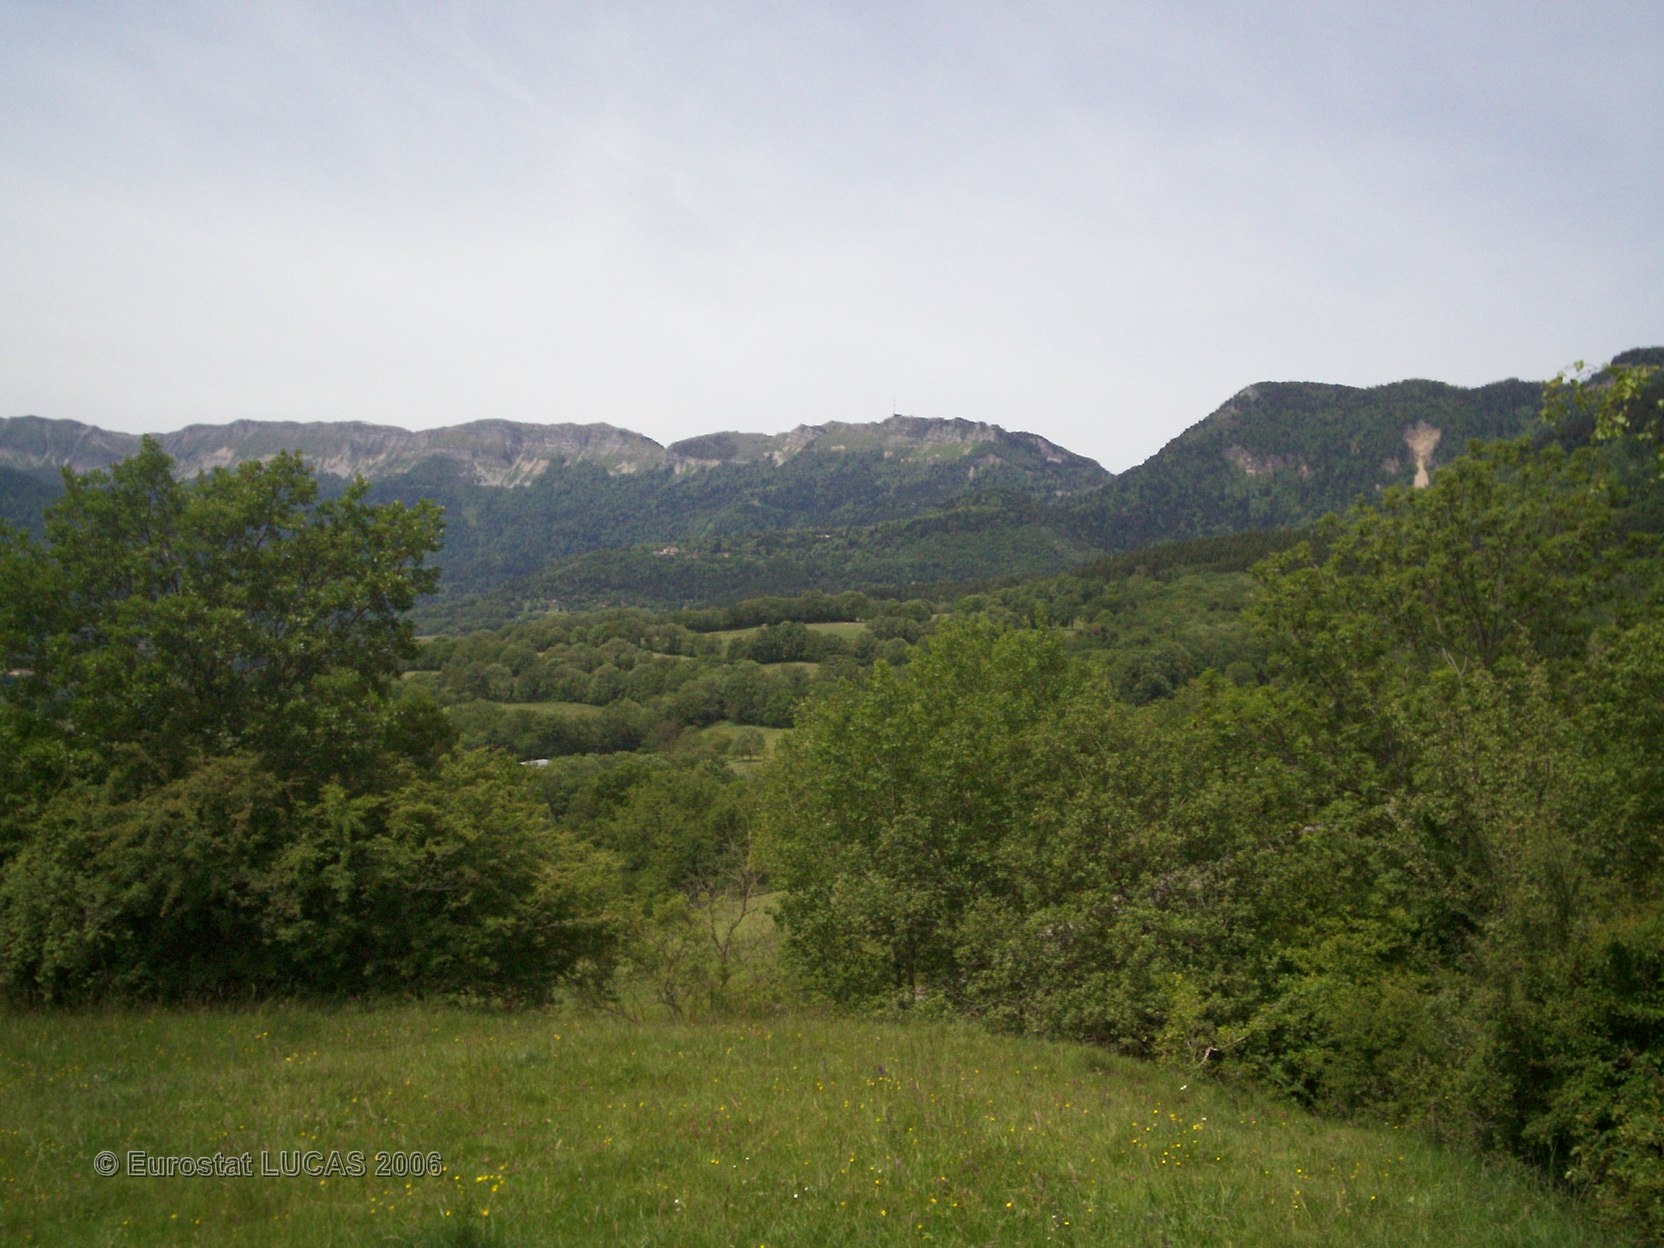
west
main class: Grassland
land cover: Grassland with sparse tree/shrub cover
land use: Agriculture (excluding fallow land and kitchen gardens)
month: June
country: FR
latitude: 46.3520
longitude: 6.0917
